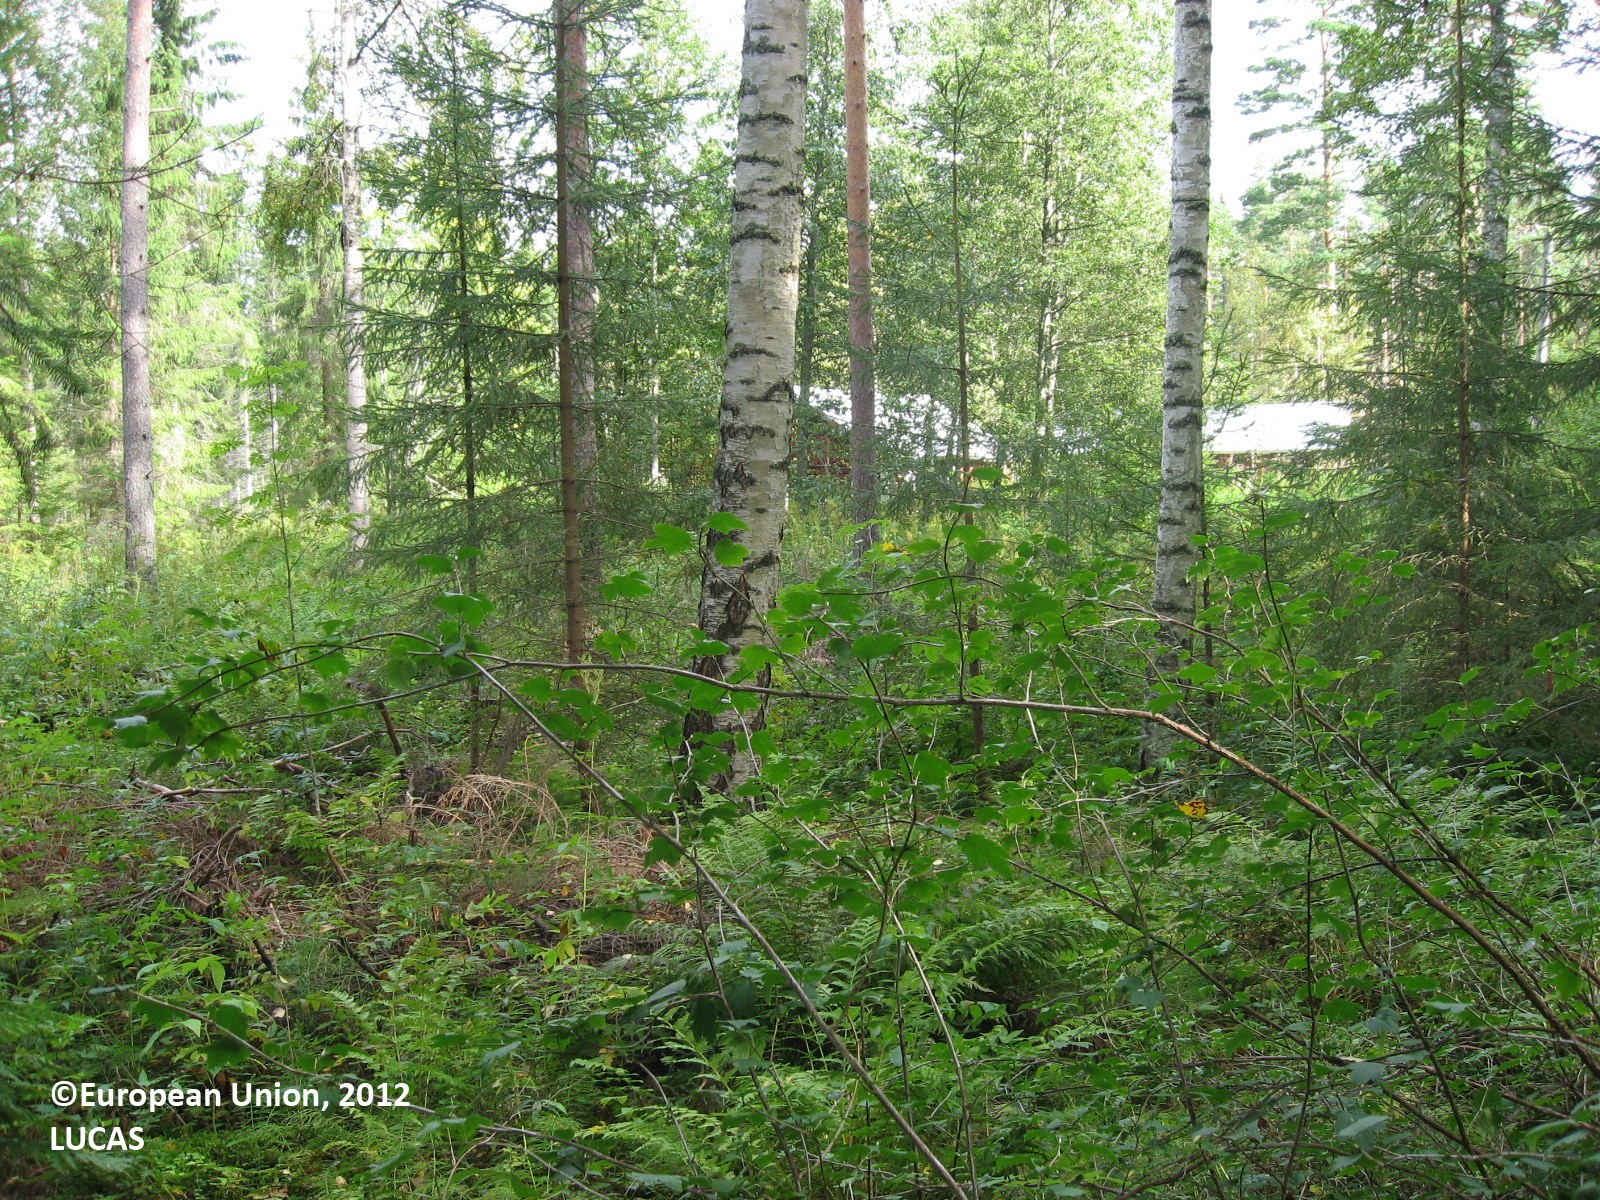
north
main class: Woodland
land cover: Spruce dominated mixed woodland
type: boreal forest
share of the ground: > 75 %
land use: Forestry
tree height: > 5 m
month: August
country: FI
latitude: 61.4475
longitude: 25.0206
